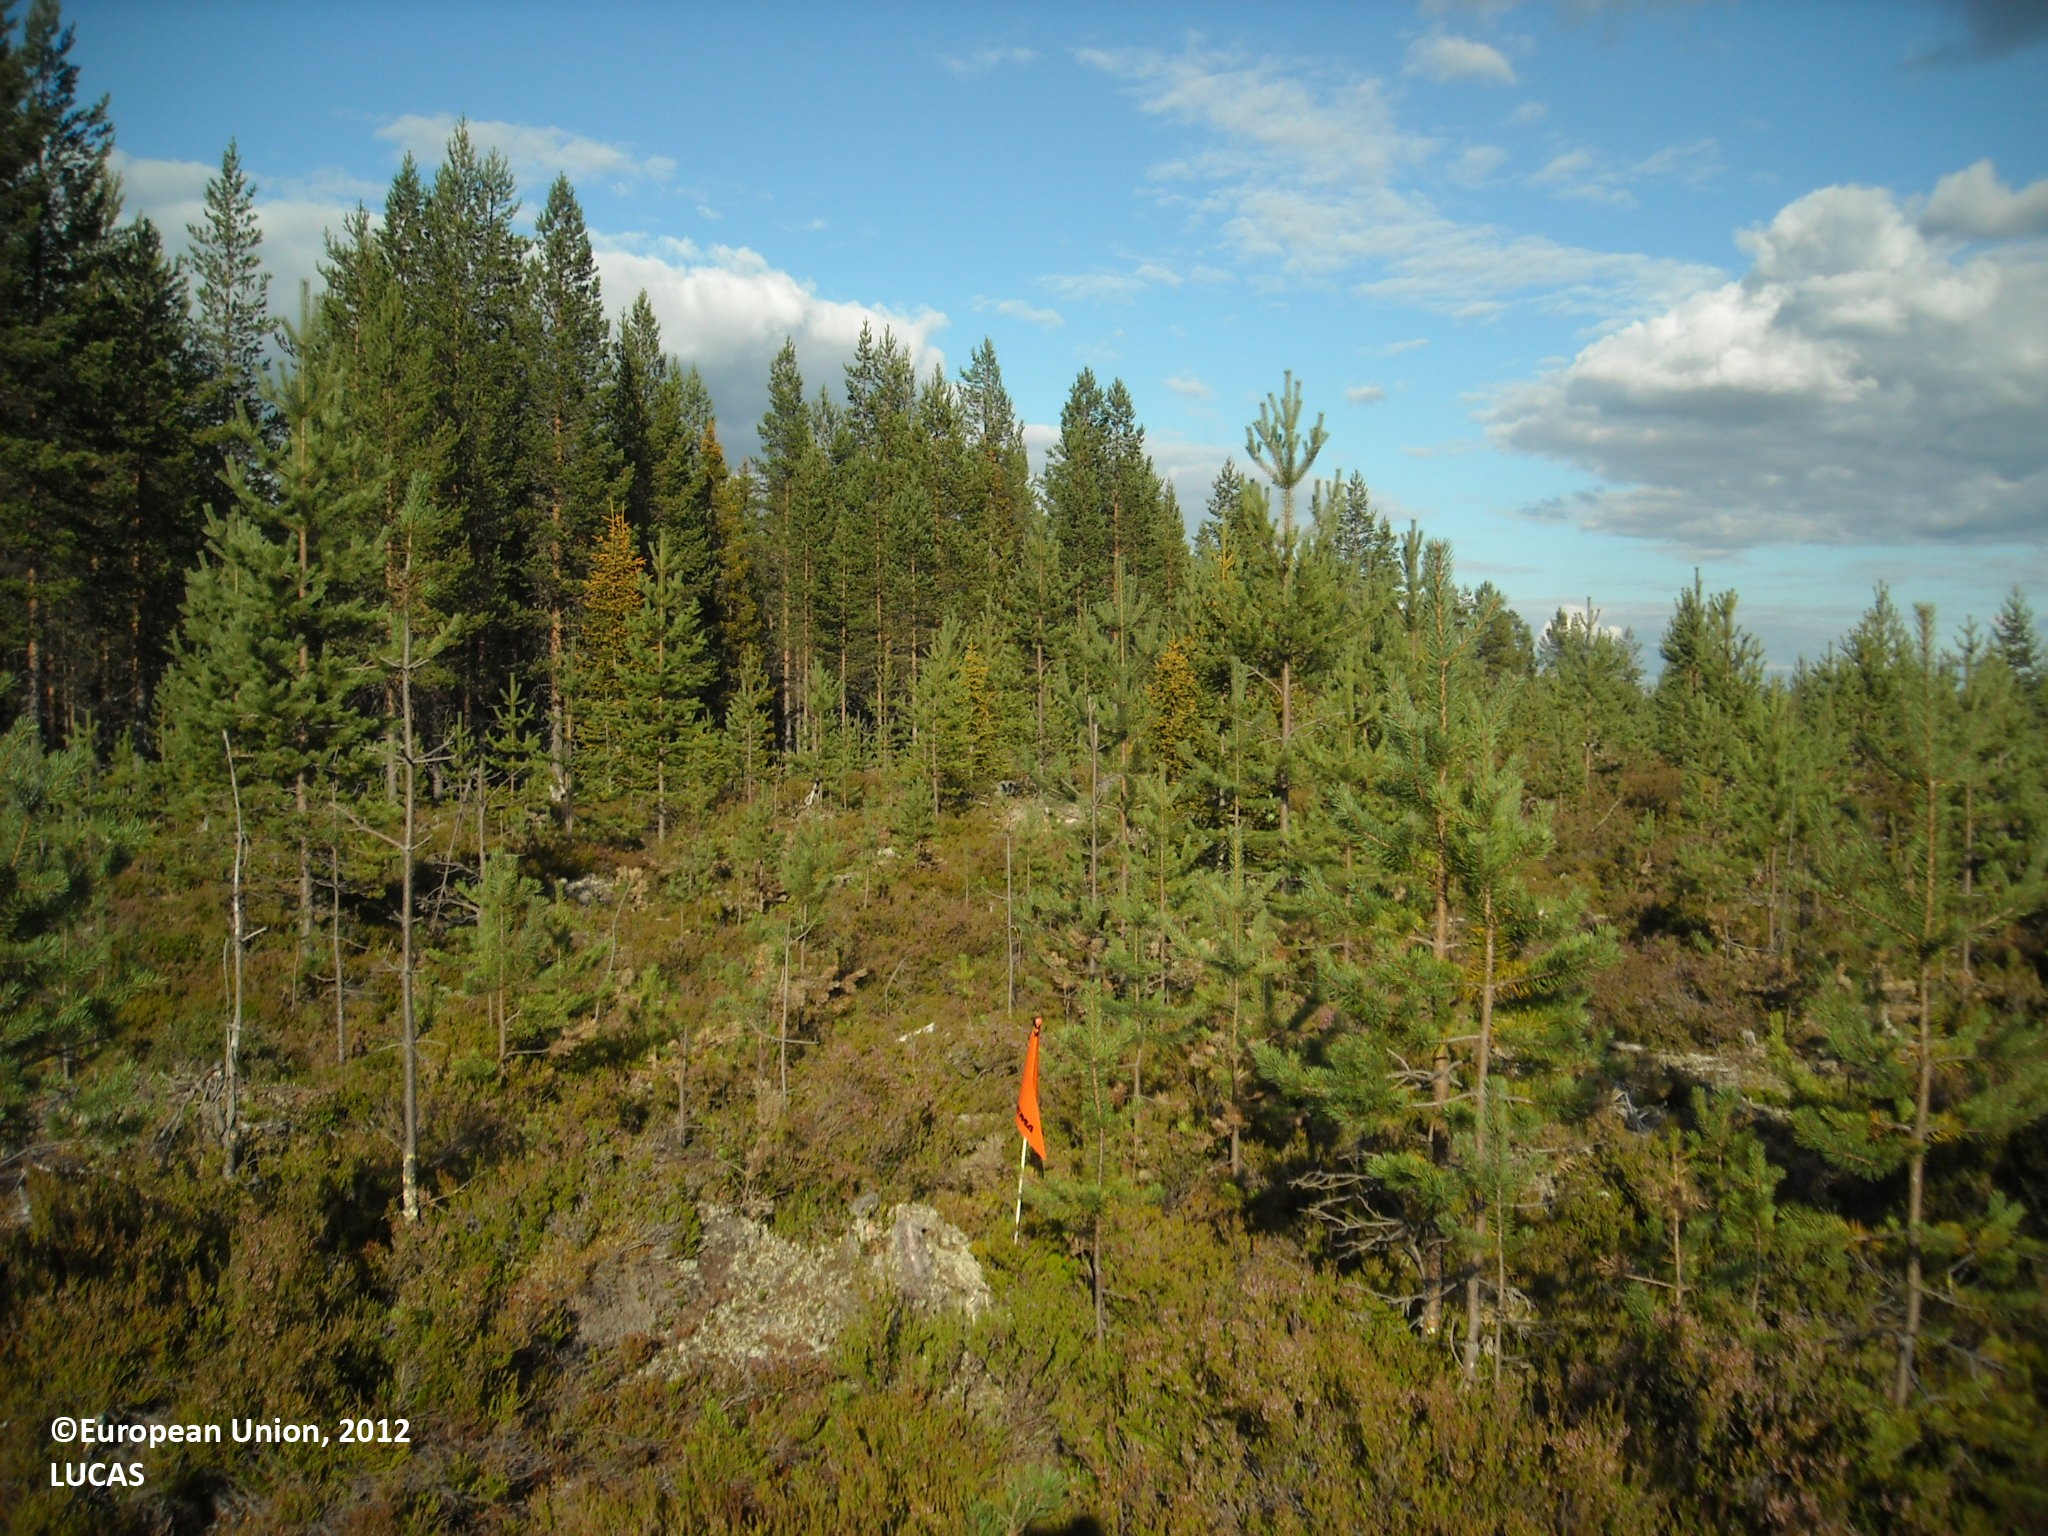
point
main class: Woodland
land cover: Pine dominated coniferous woodland
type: boreal forest
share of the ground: 25 - 50 %
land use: Forestry
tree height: < 5 m
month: August
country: FI
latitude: 65.5167
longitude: 27.8508
